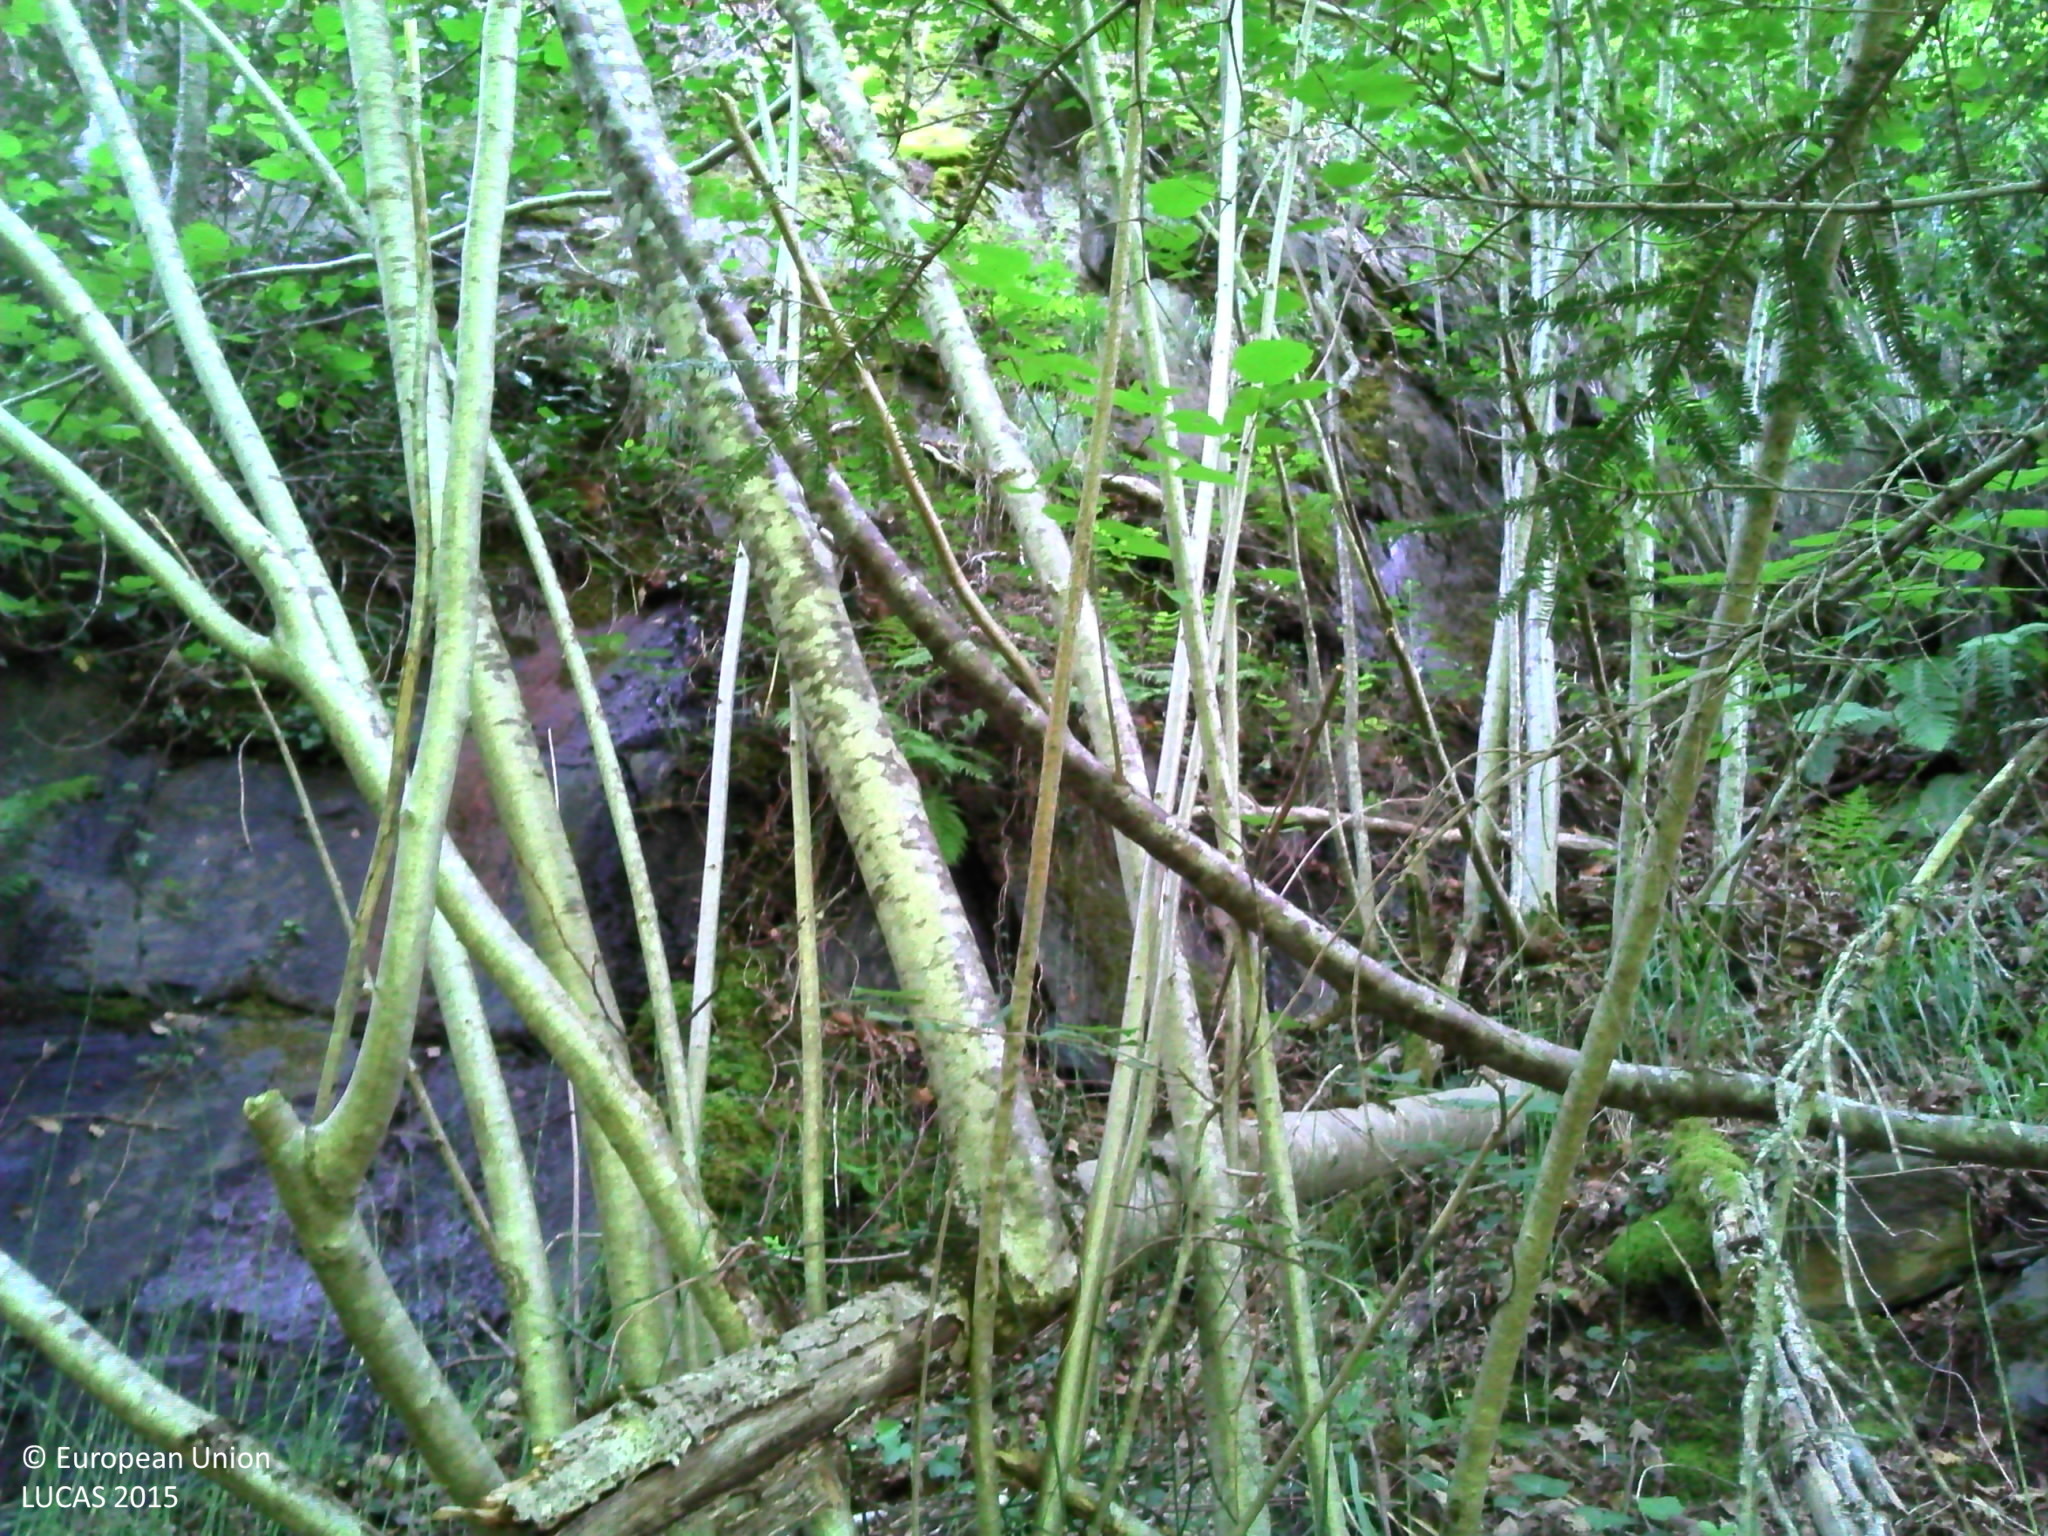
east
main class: Woodland
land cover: Broadleaved woodland
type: mesophytic deciduous forest
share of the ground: > 75 %
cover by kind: broadleaved forest trees 80 %, unconsolidated bare surface 10 %, shrubs 5 %, herbaceous plants 5 %
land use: Semi-natural and natural areas not in use
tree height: > 5 m
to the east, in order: Broadleaved woodland; Rock outcrops; Broadleaved woodland
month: July
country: FR
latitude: 42.9312
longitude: -0.0863
